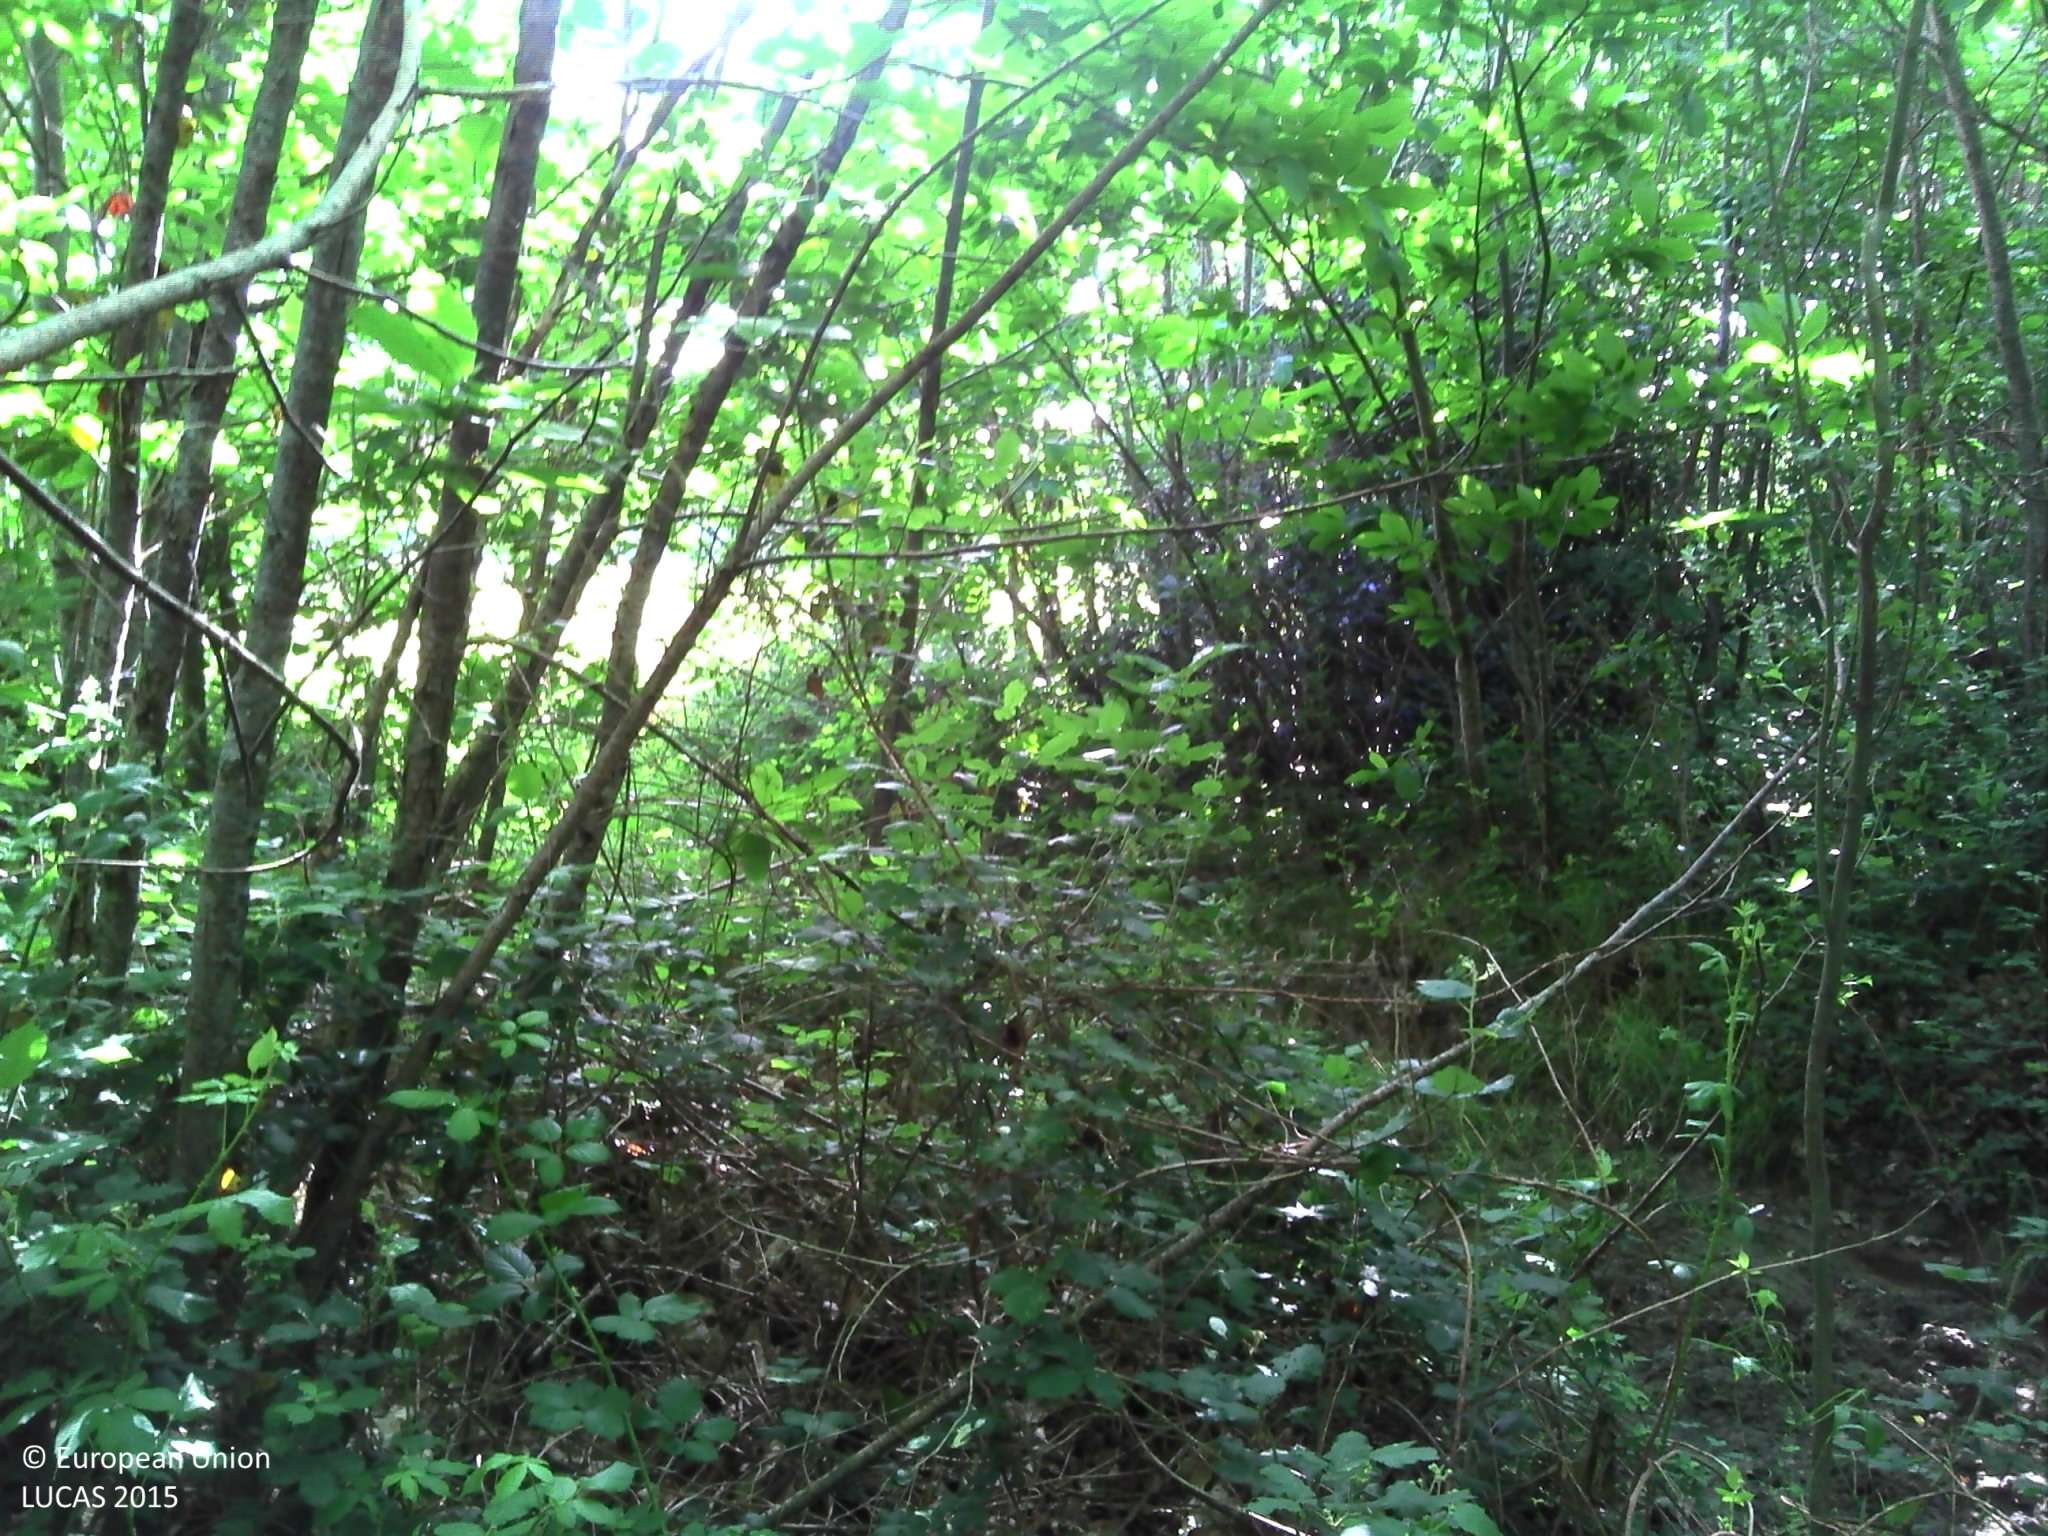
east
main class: Woodland
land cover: Broadleaved woodland
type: mesophytic deciduous forest
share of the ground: > 75 %
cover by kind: broadleaved forest trees 95 %, herbaceous plants 5 %
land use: Forestry
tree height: > 5 m
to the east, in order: Broadleaved woodland; Tracks; Broadleaved woodland; Fences; Grassland without tree/shrub cover; Fences; Vineyards; Fences; Grassland without tree/shrub cover; Artificial constructions in urban areas
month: June
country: FR
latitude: 47.2072
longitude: -1.2736
